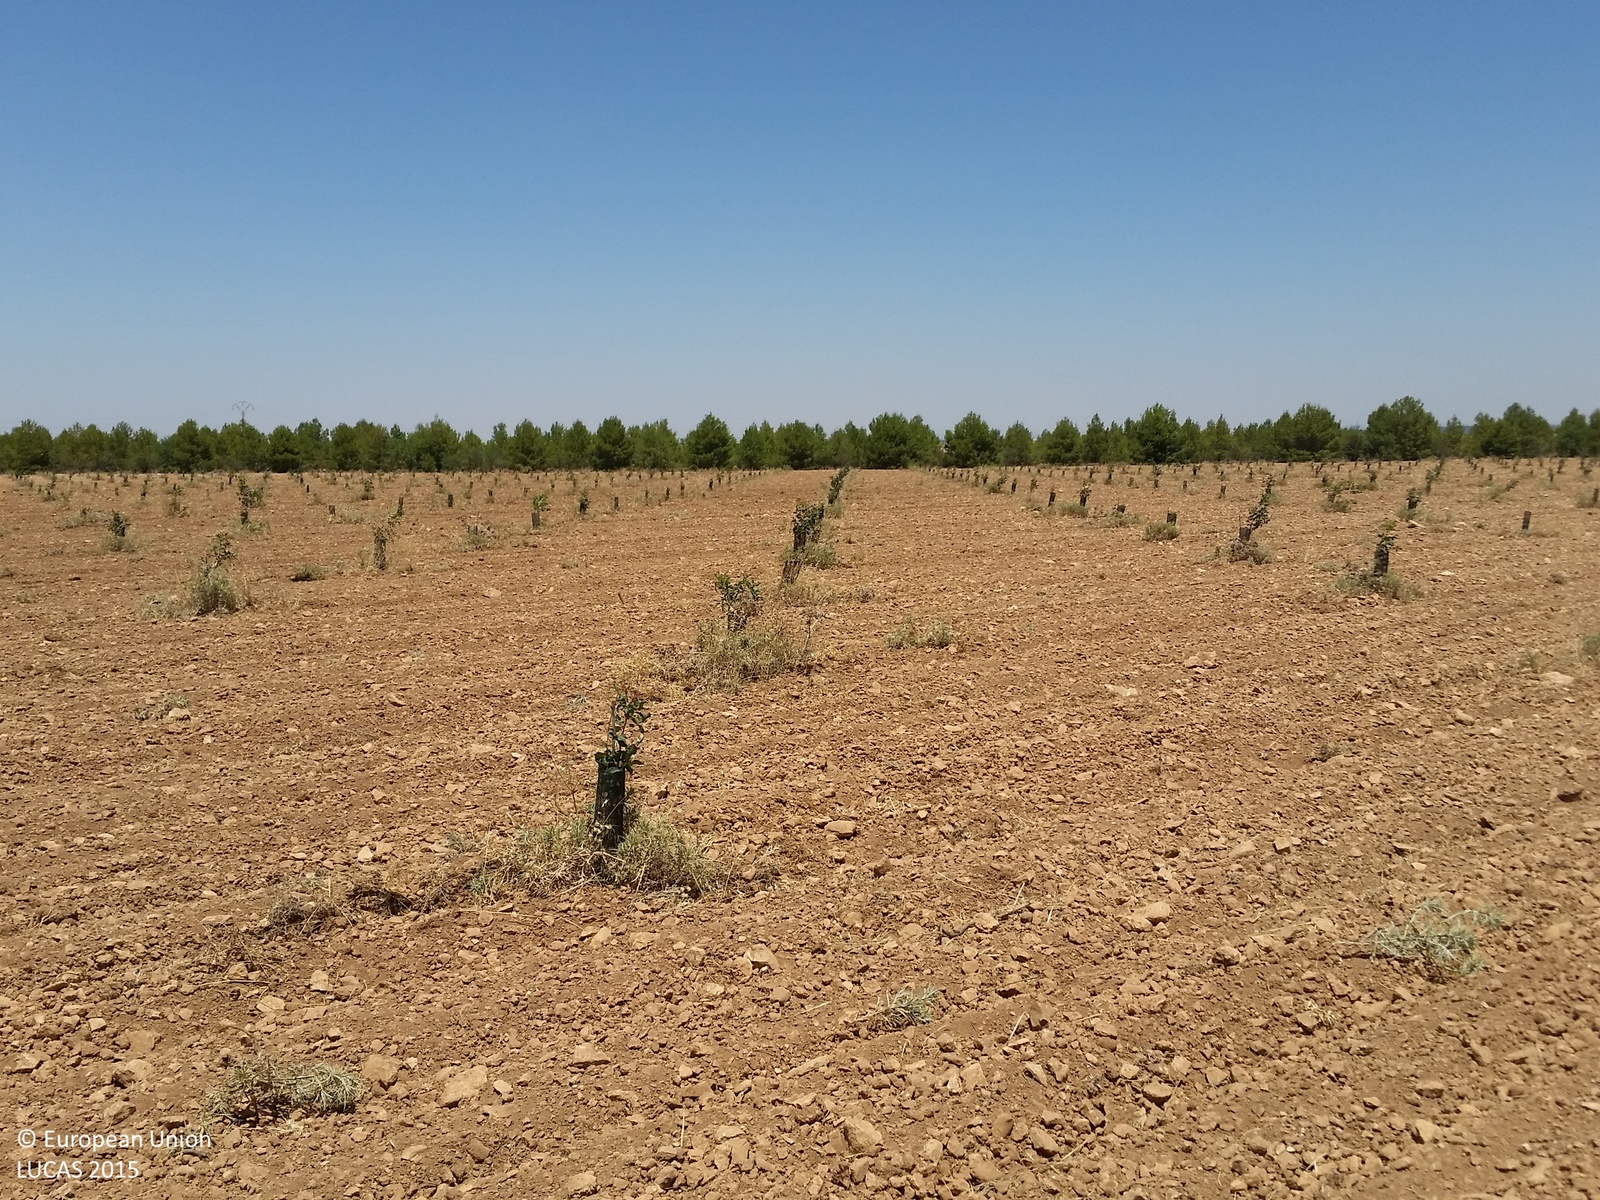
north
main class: Cropland
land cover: Nuts trees
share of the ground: < 10 %
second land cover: Other bare soil
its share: > 75 %
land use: Agriculture (excluding fallow land and kitchen gardens)
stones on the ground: 10 - 25 %
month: July
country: ES
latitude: 39.1276
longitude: -2.5586
